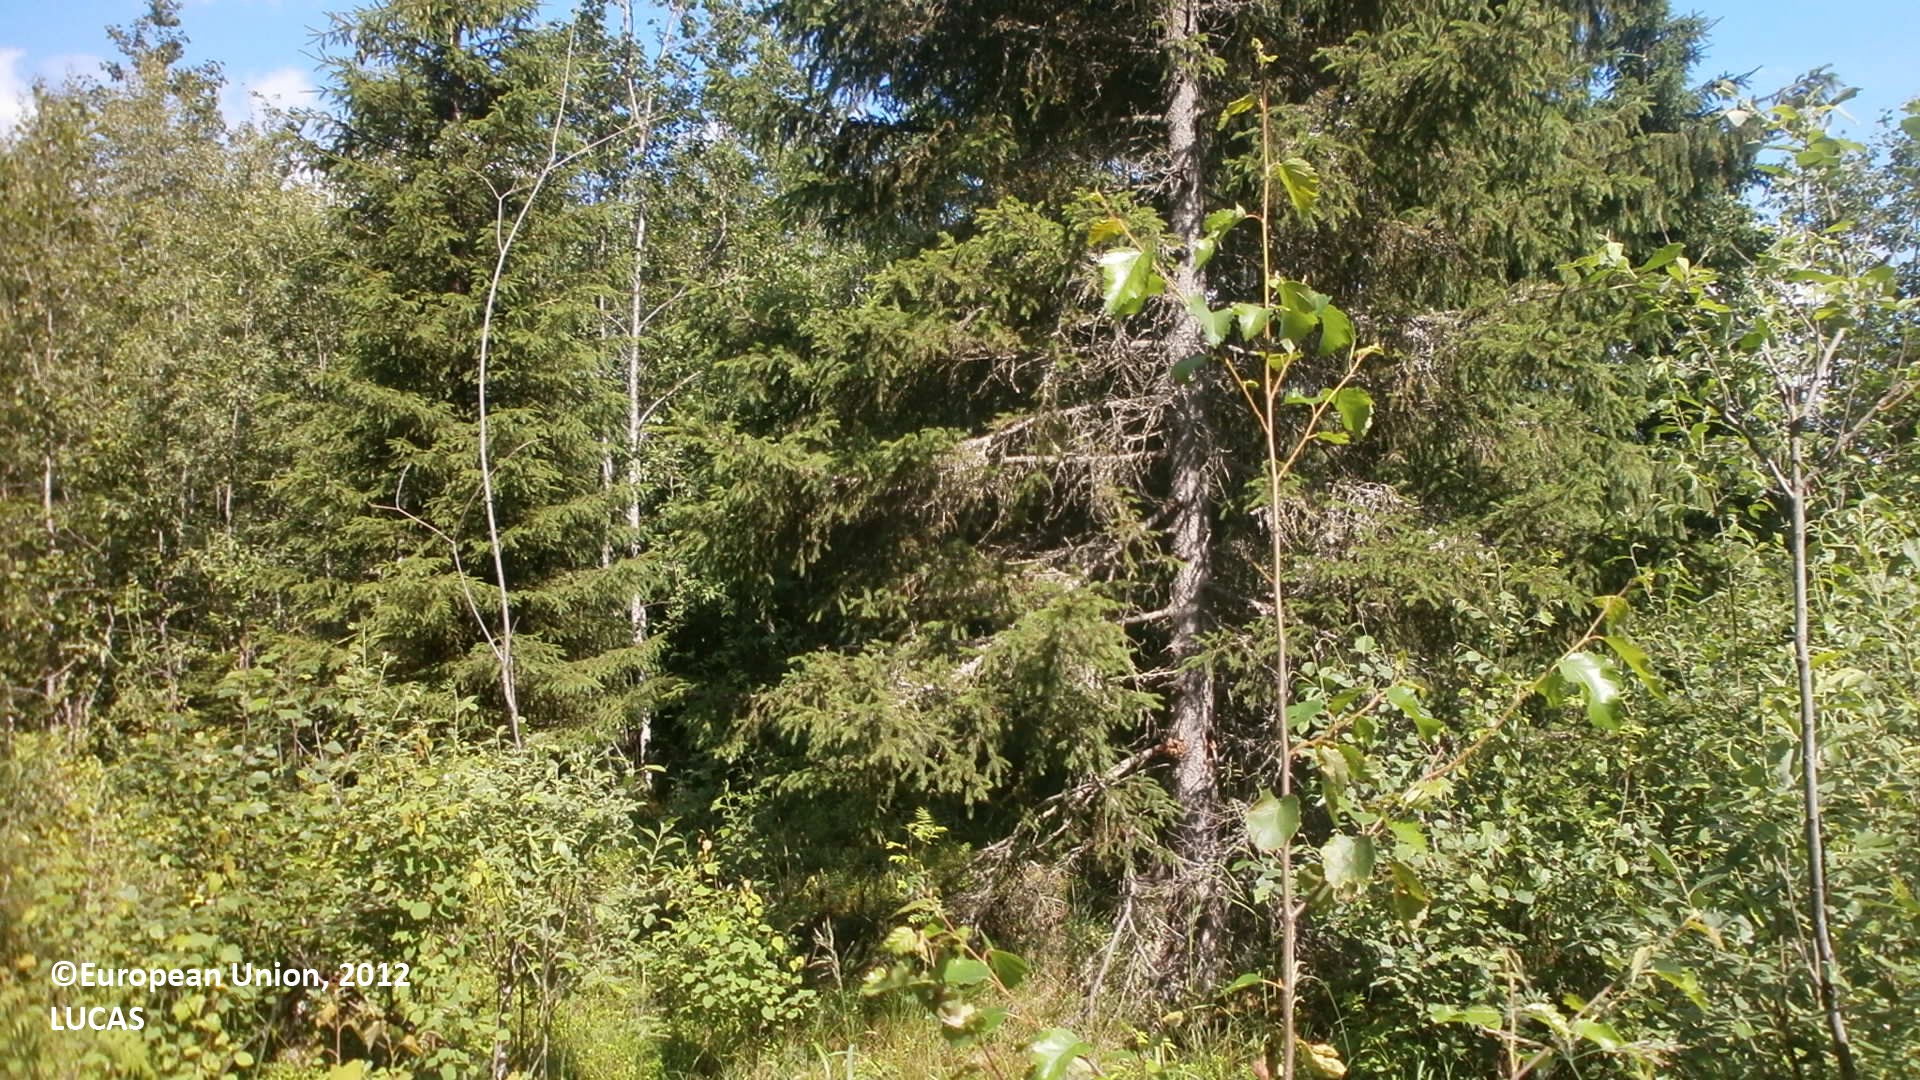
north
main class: Woodland
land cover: Spruce dominated mixed woodland
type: boreal forest
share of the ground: 50 - 75 %
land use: Forestry
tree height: > 5 m
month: July
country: FI
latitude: 64.4277
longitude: 24.5007
